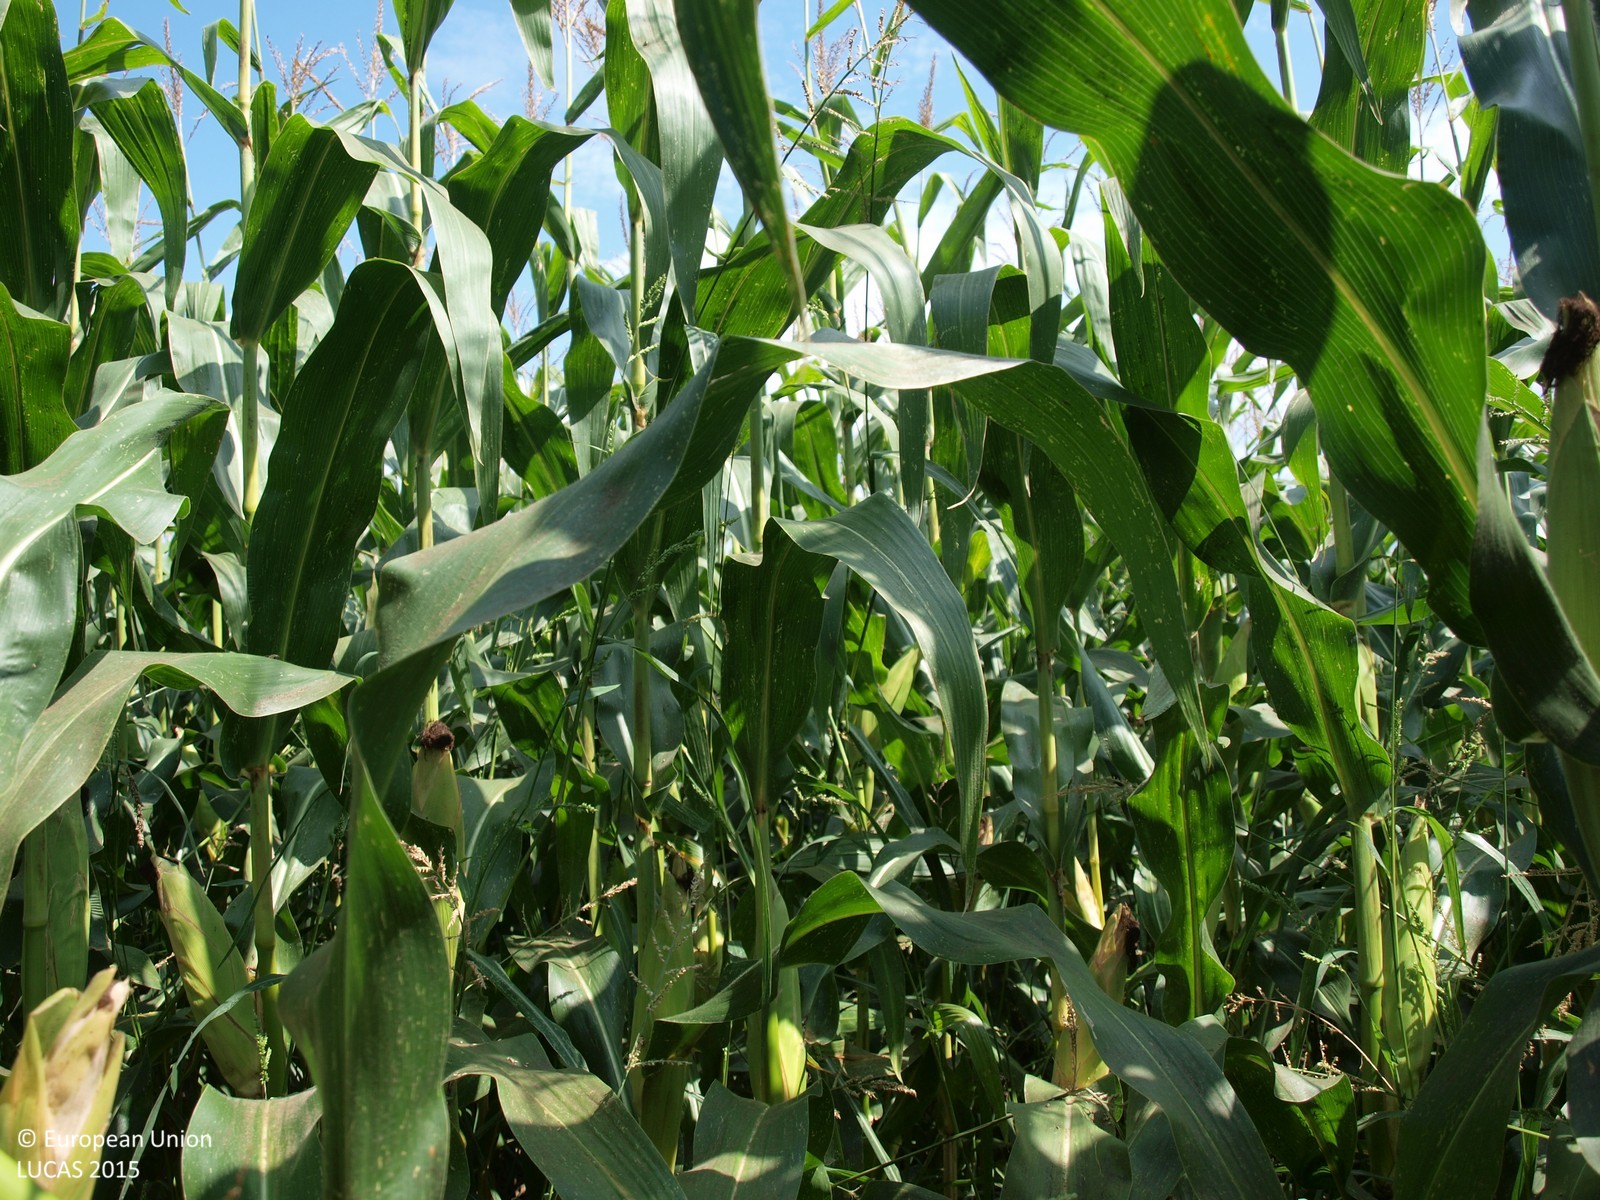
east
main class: Cropland
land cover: Maize
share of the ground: > 75 %
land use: Agriculture (excluding fallow land and kitchen gardens)
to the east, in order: Maize; Ditches and canals; Grassland without tree/shrub cover; Tracks; Maize; Managed hedges; Artificial constructions in urban areas
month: August
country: HR
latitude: 46.0793
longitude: 16.5301
